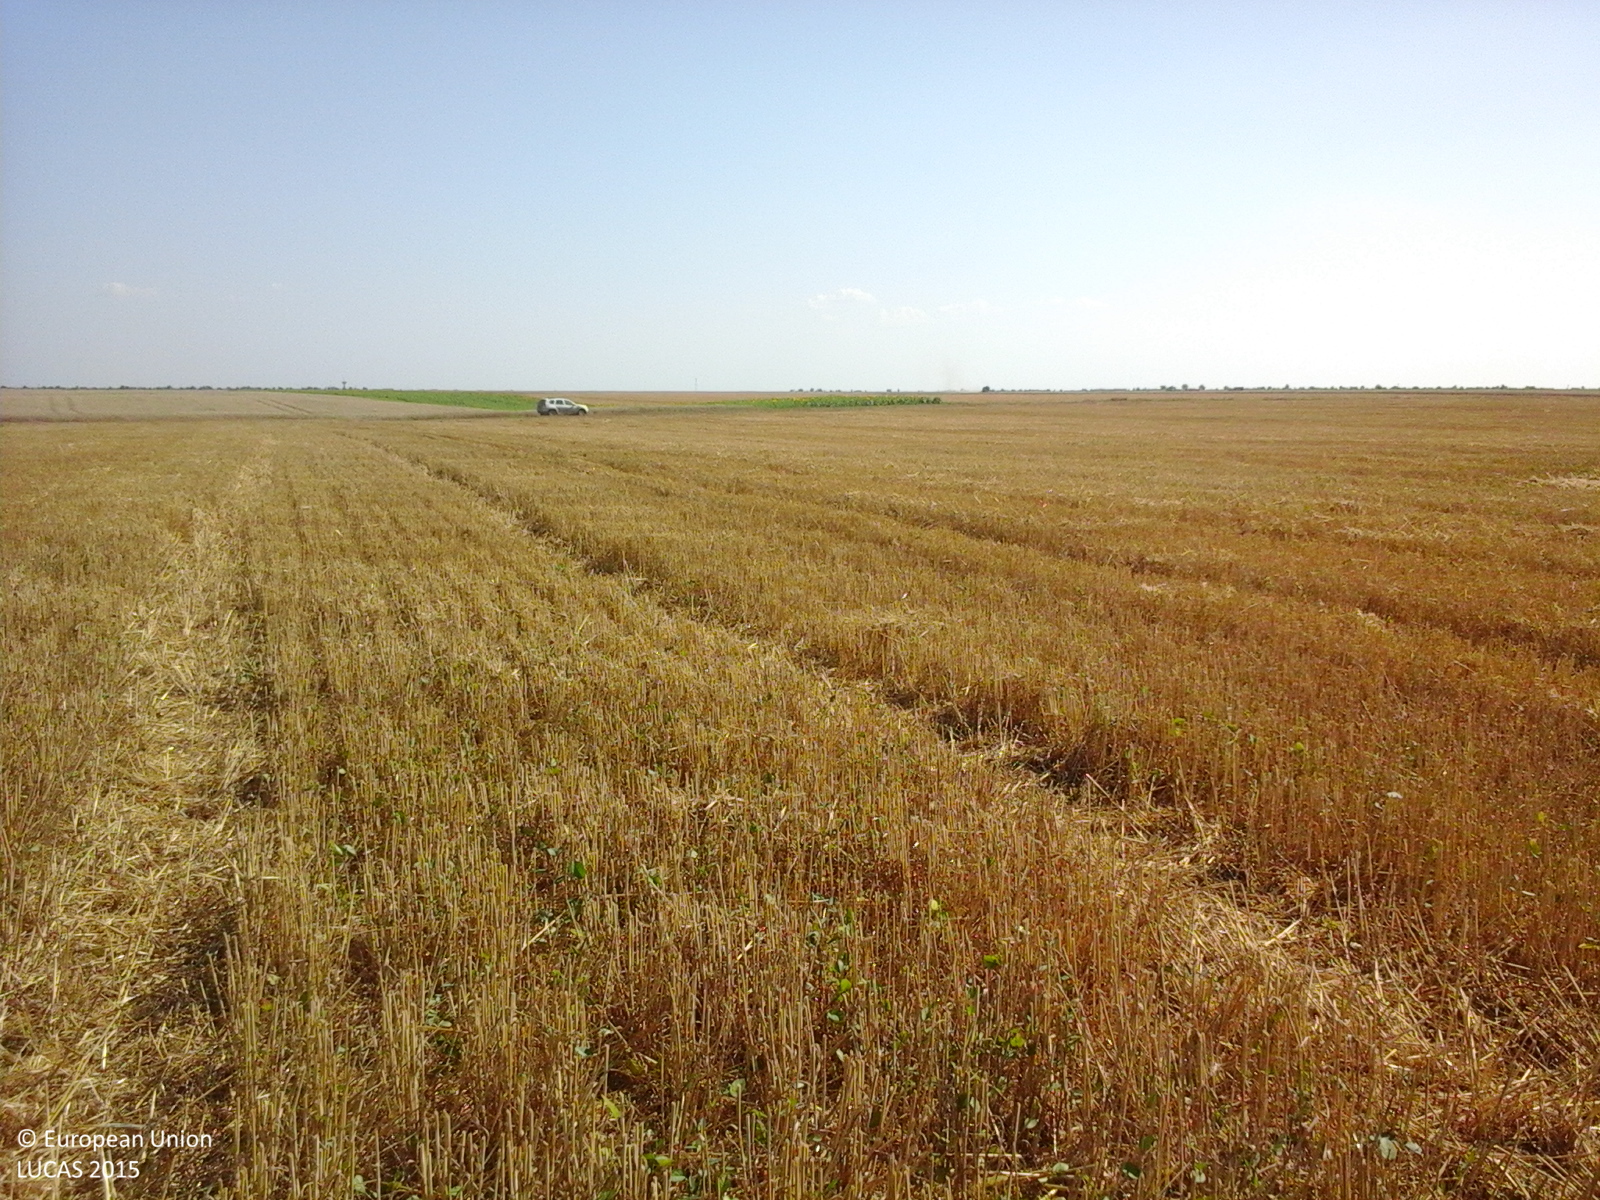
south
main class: Cropland
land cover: Common wheat
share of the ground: 50 - 75 %
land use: Agriculture (excluding fallow land and kitchen gardens)
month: July
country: RO
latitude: 44.2188
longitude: 24.5261
